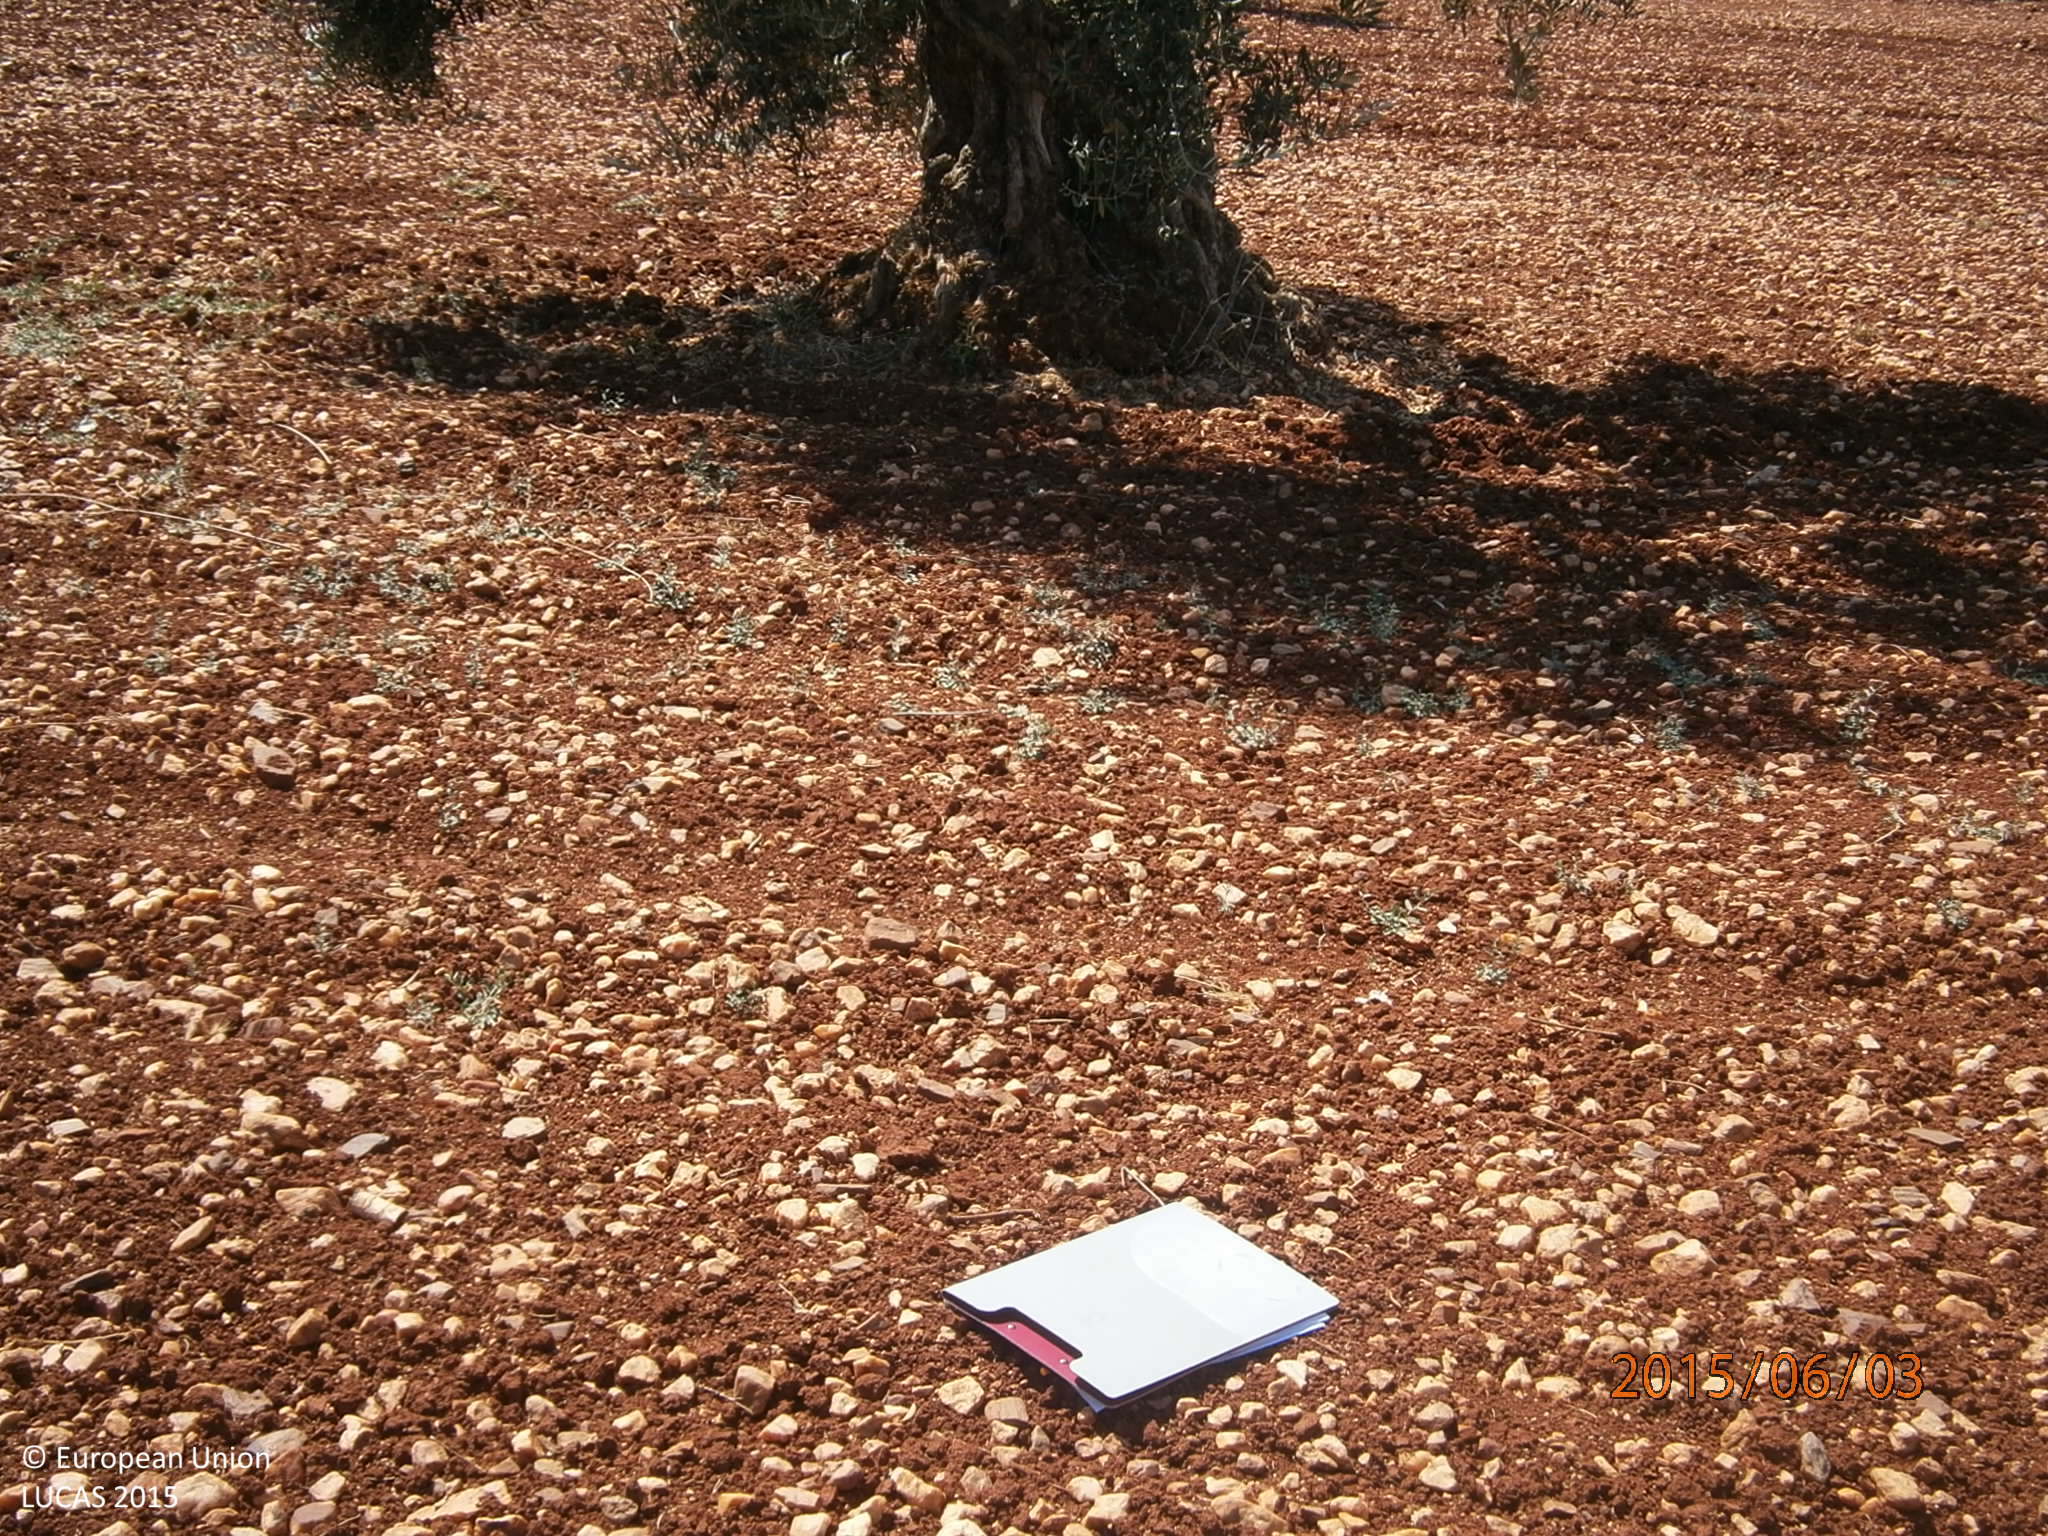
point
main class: Cropland
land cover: Olive groves
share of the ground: 10 - 25 %
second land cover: Other bare soil
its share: > 75 %
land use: Agriculture (excluding fallow land and kitchen gardens)
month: June
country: ES
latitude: 38.6330
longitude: -6.4240
